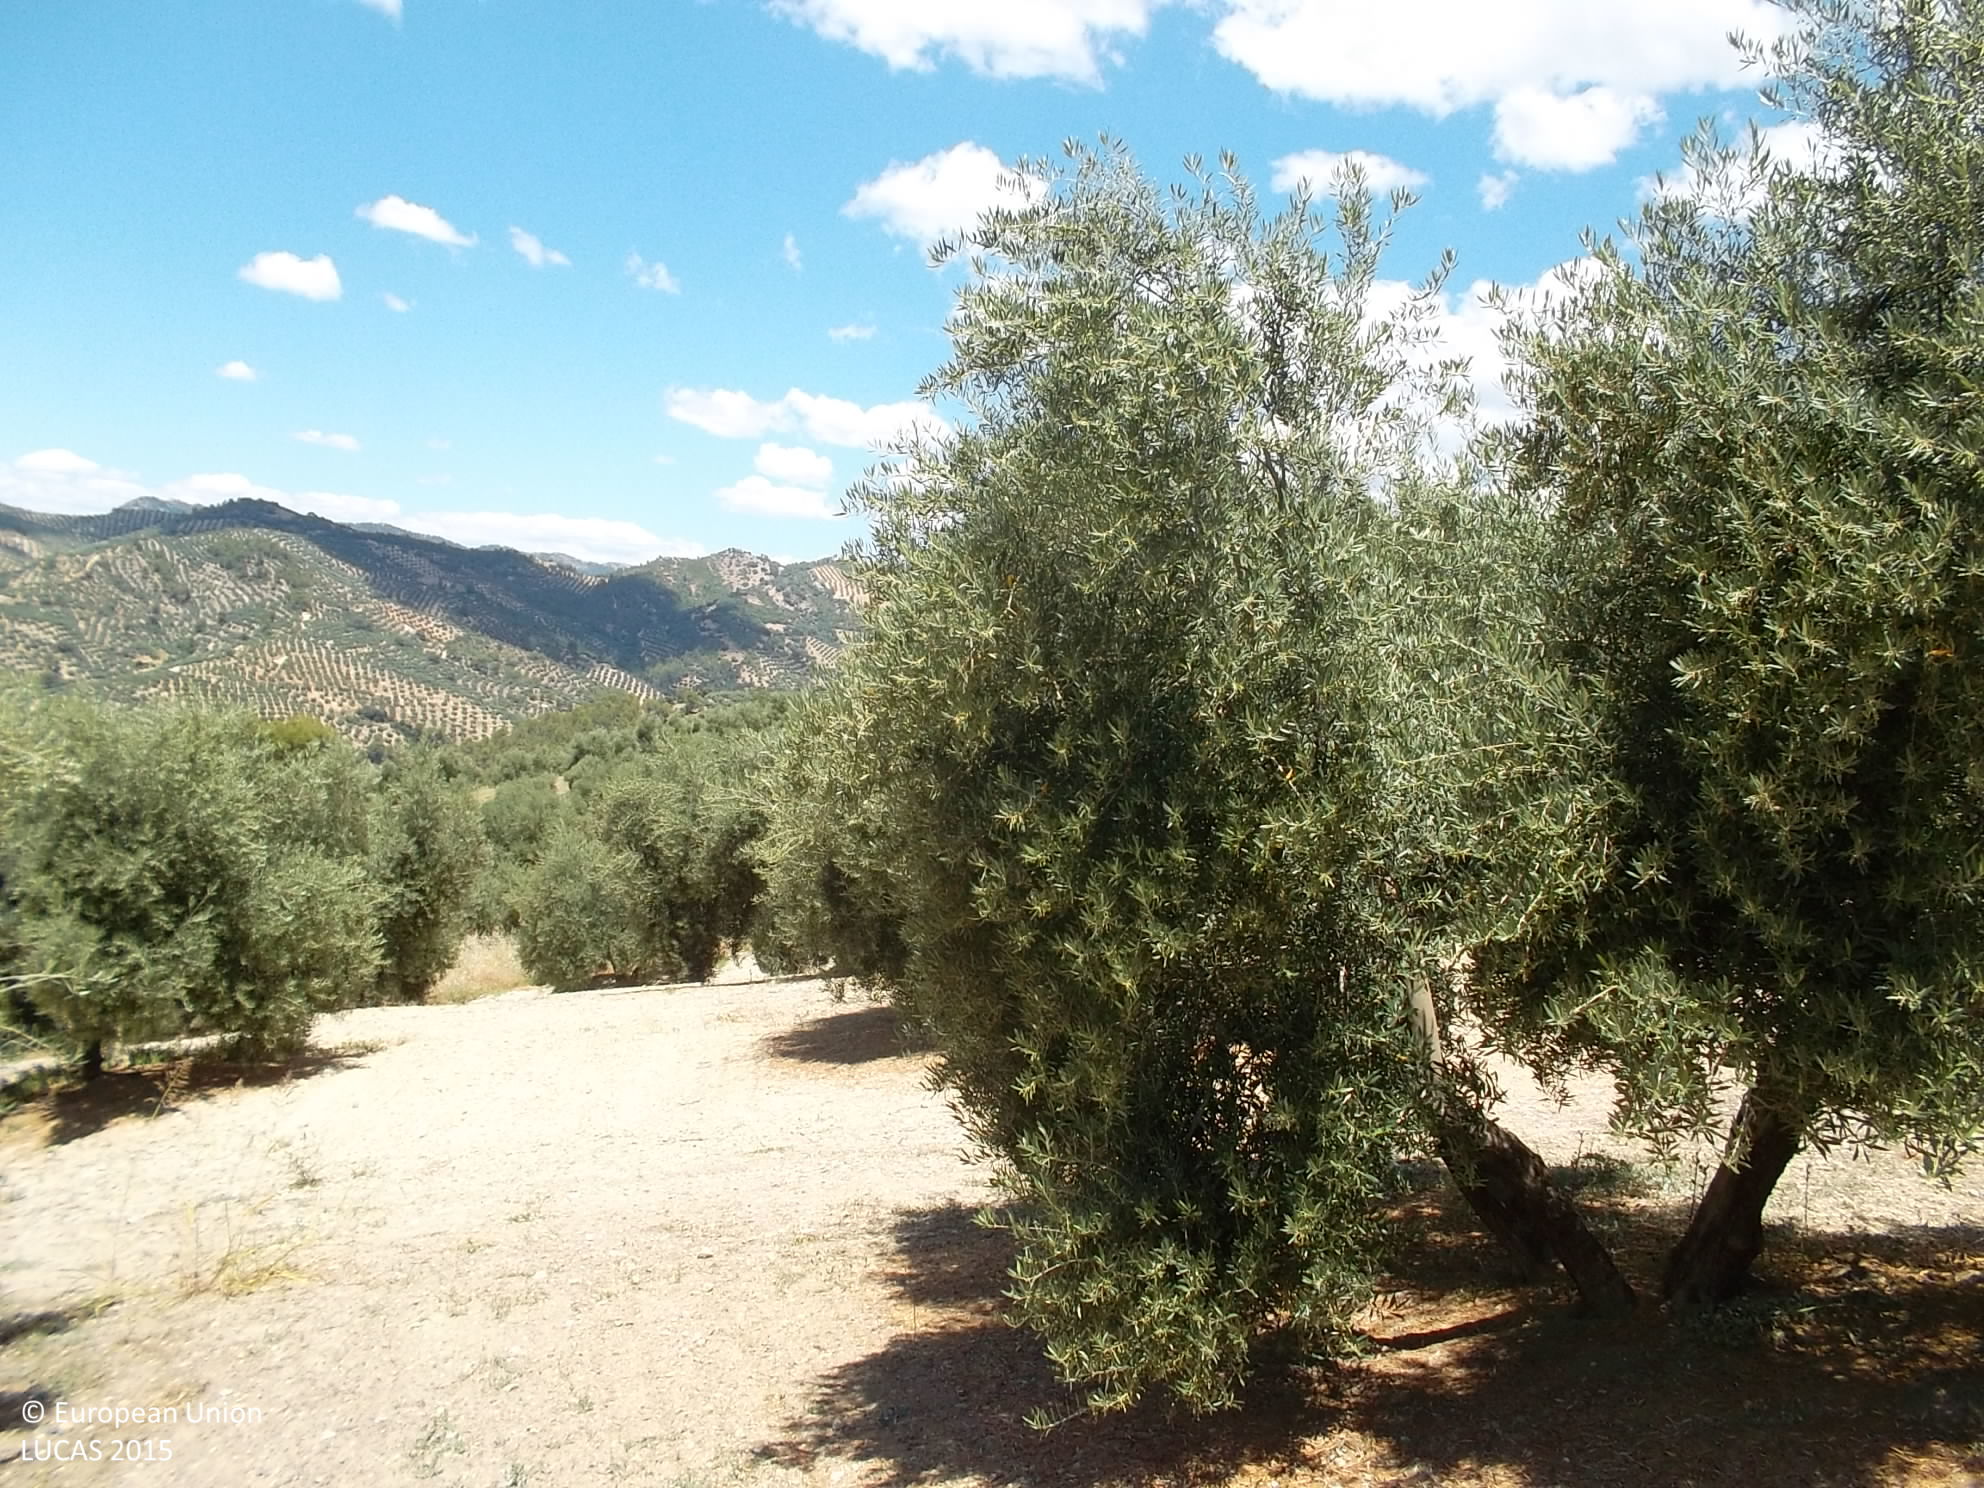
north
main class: Cropland
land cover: Olive groves
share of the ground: 25 - 50 %
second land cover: Other bare soil
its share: > 75 %
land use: Agriculture (excluding fallow land and kitchen gardens)
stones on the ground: < 10 %
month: June
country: ES
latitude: 37.9570
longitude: -2.9587
